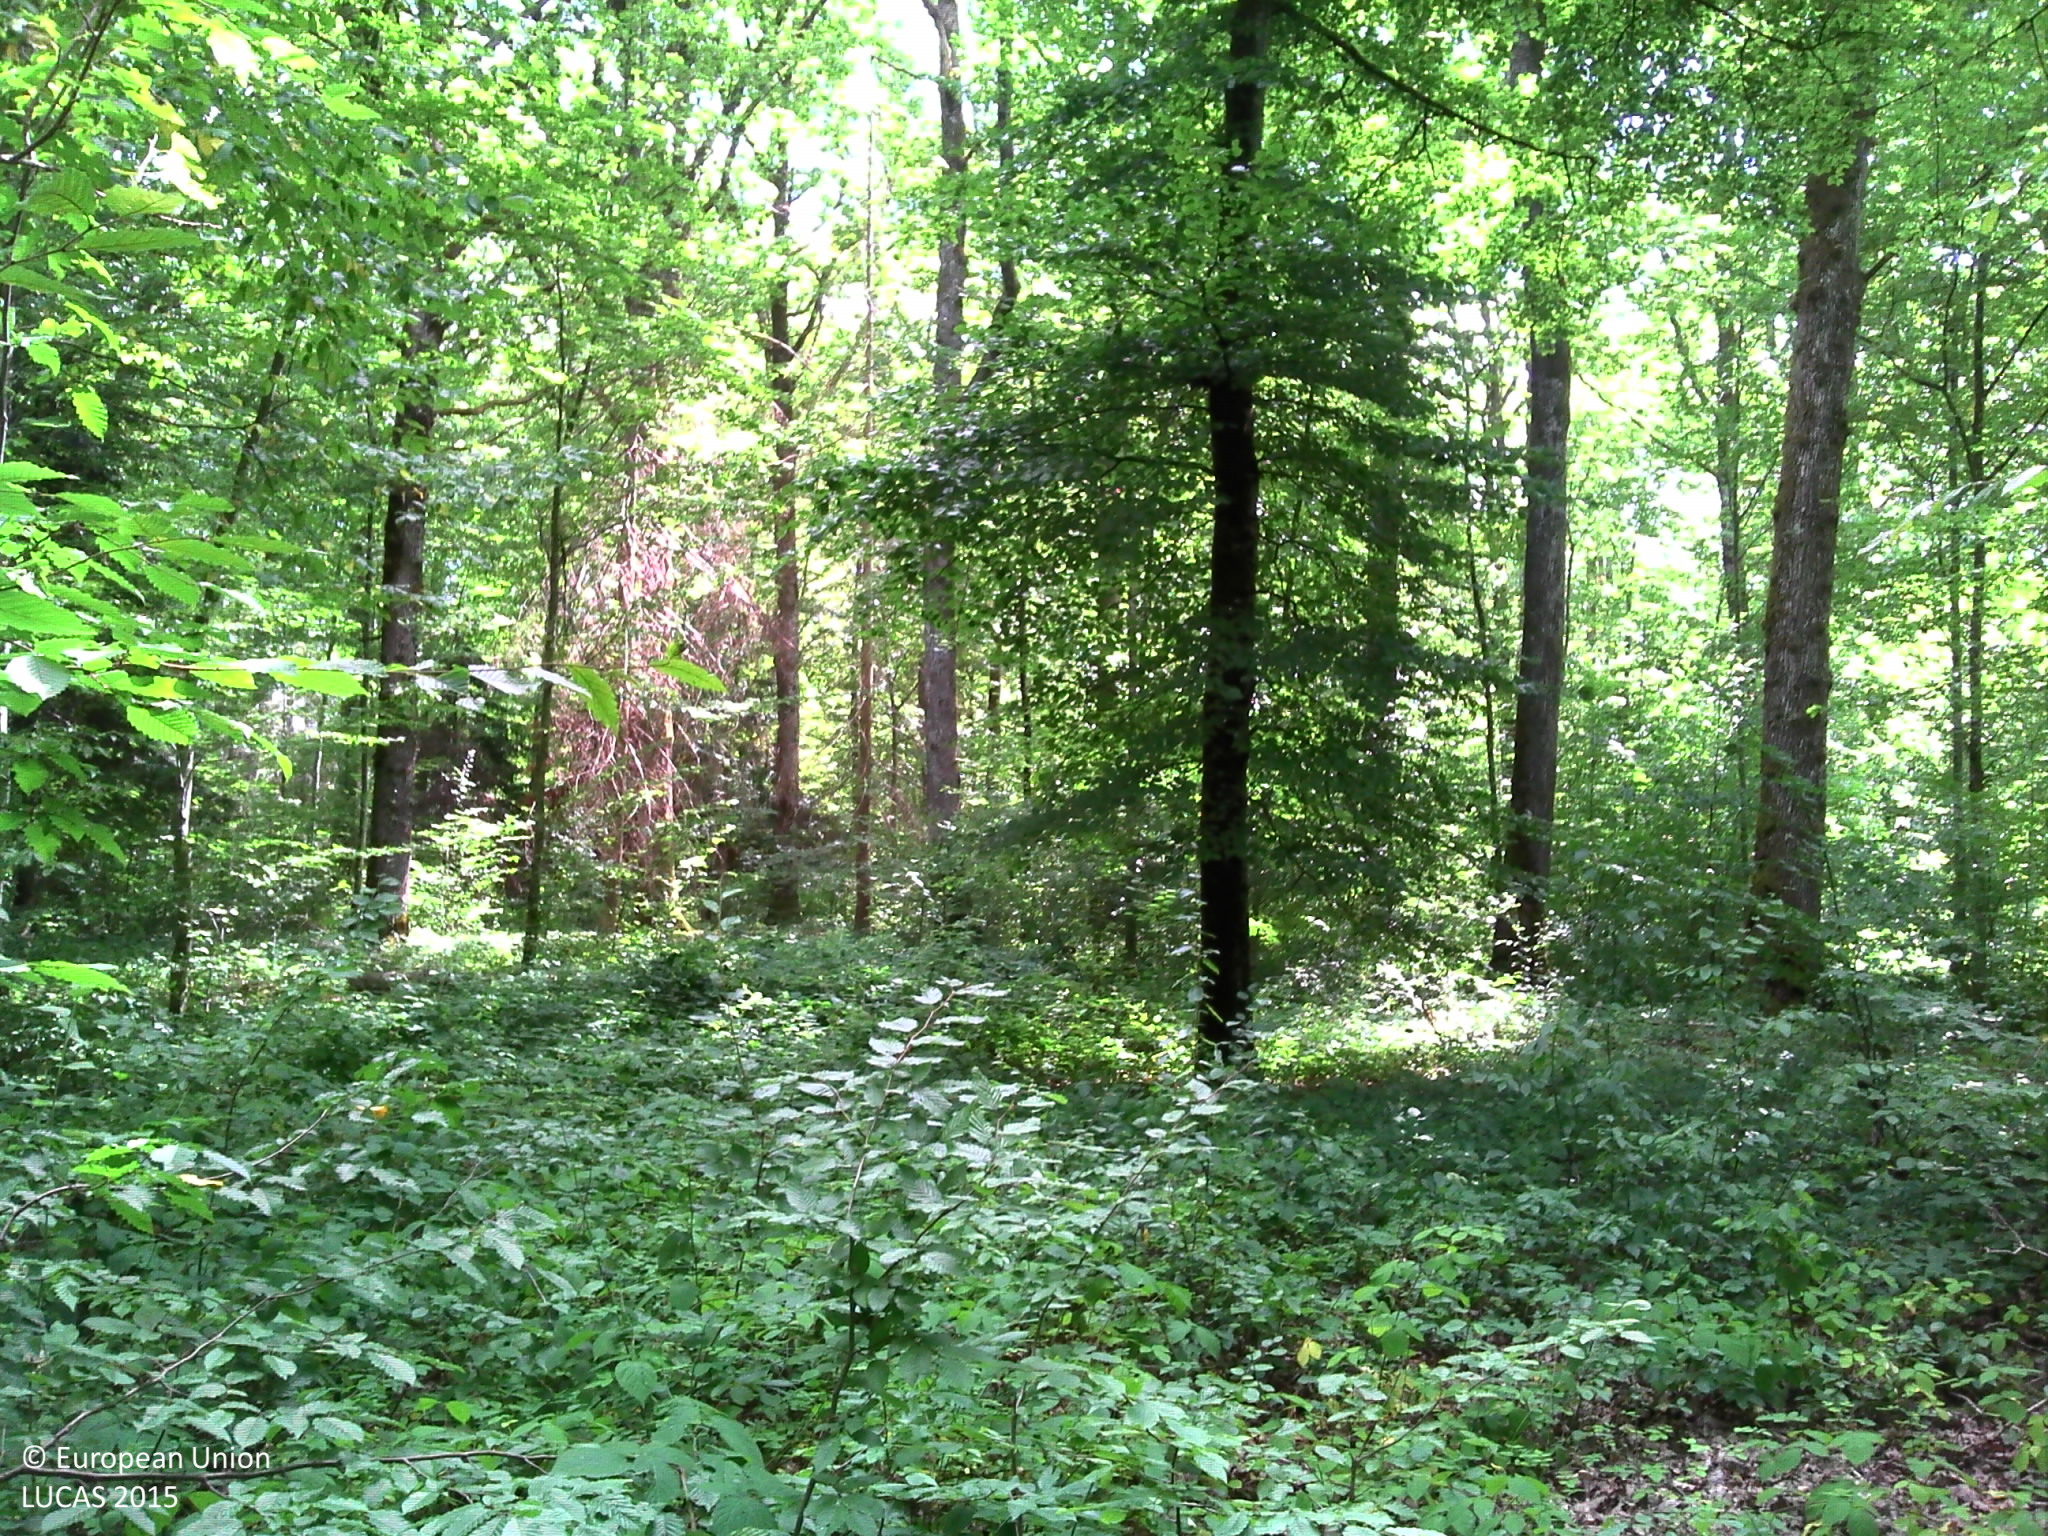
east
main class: Woodland
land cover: Broadleaved woodland
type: mesophytic deciduous forest
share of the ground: > 75 %
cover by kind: broadleaved forest trees 70 %, herbaceous plants 20 %, coniferous forest trees 5 %, lichens and mosses 5 %
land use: Forestry
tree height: > 5 m
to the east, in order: Broadleaved woodland; Grass margins; Tracks; Common wheat
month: July
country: FR
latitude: 47.7433
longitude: 5.2655
